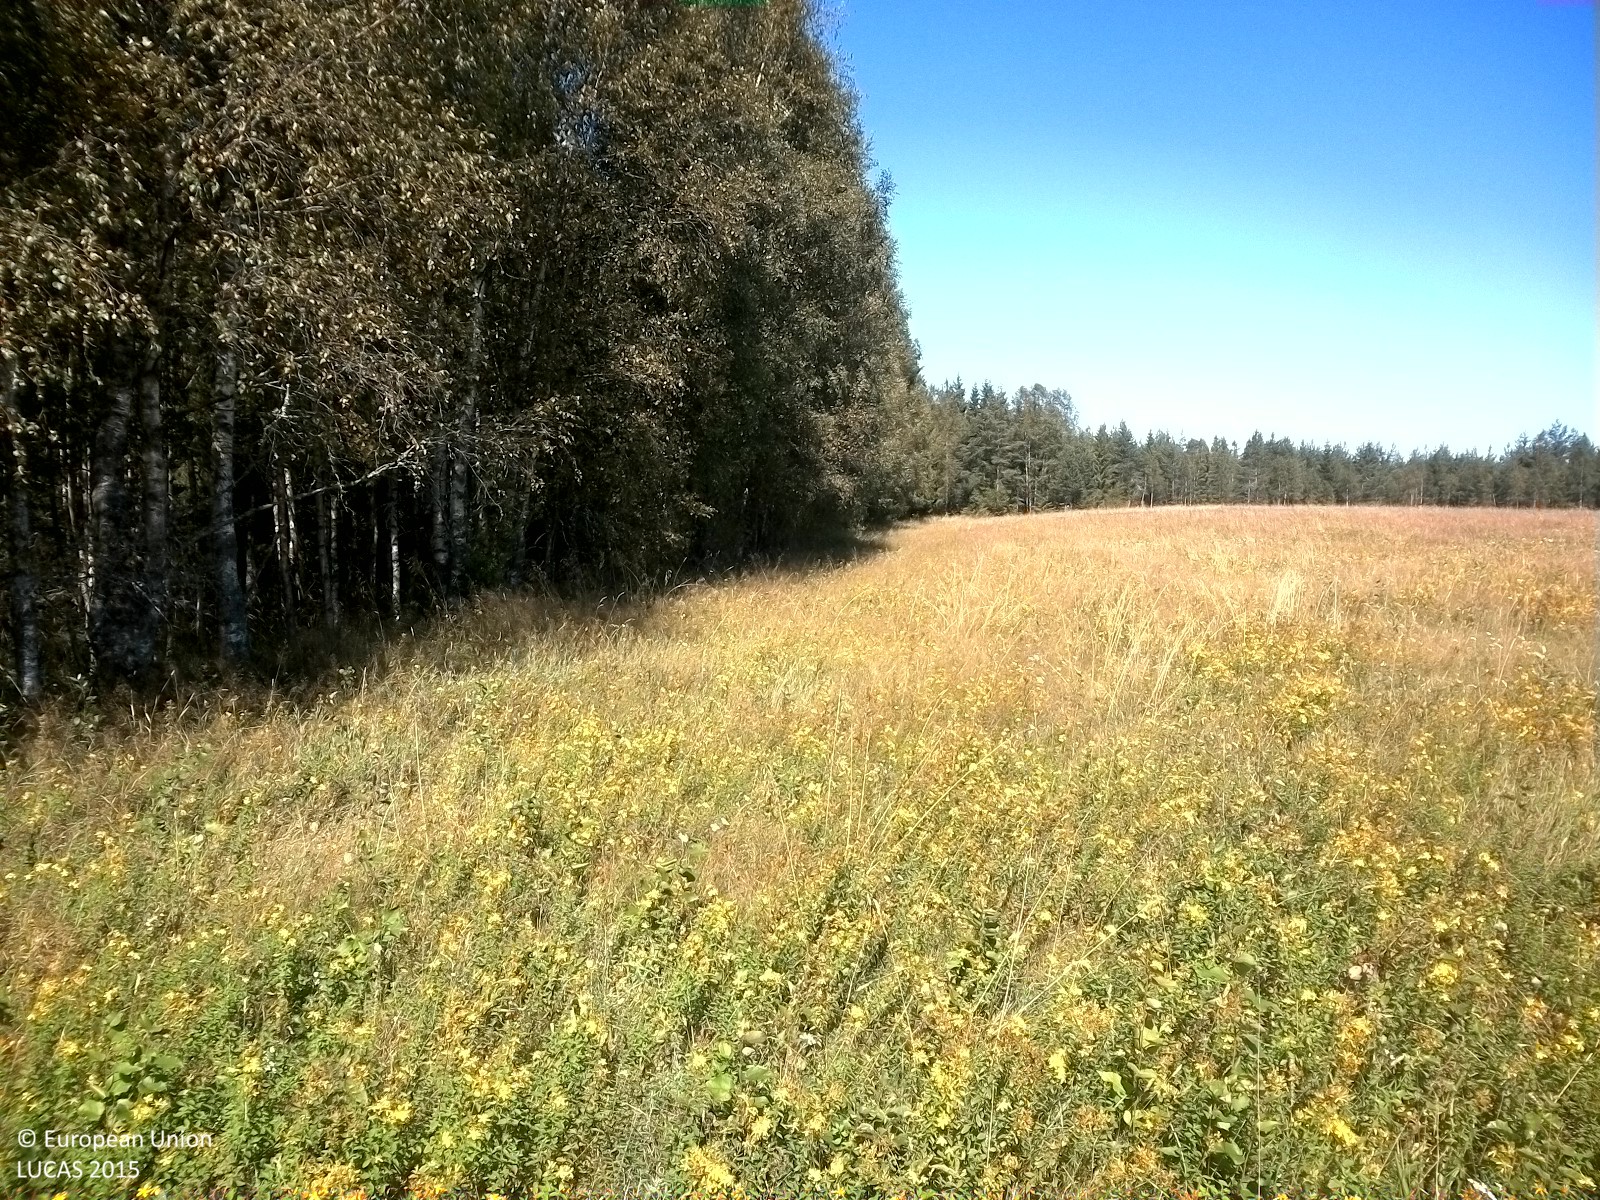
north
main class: Grassland
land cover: Grassland without tree/shrub cover
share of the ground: > 75 %
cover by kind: herbaceous plants 100 %
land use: Semi-natural and natural areas not in use
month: August
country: SE
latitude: 59.3982
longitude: 14.7286
